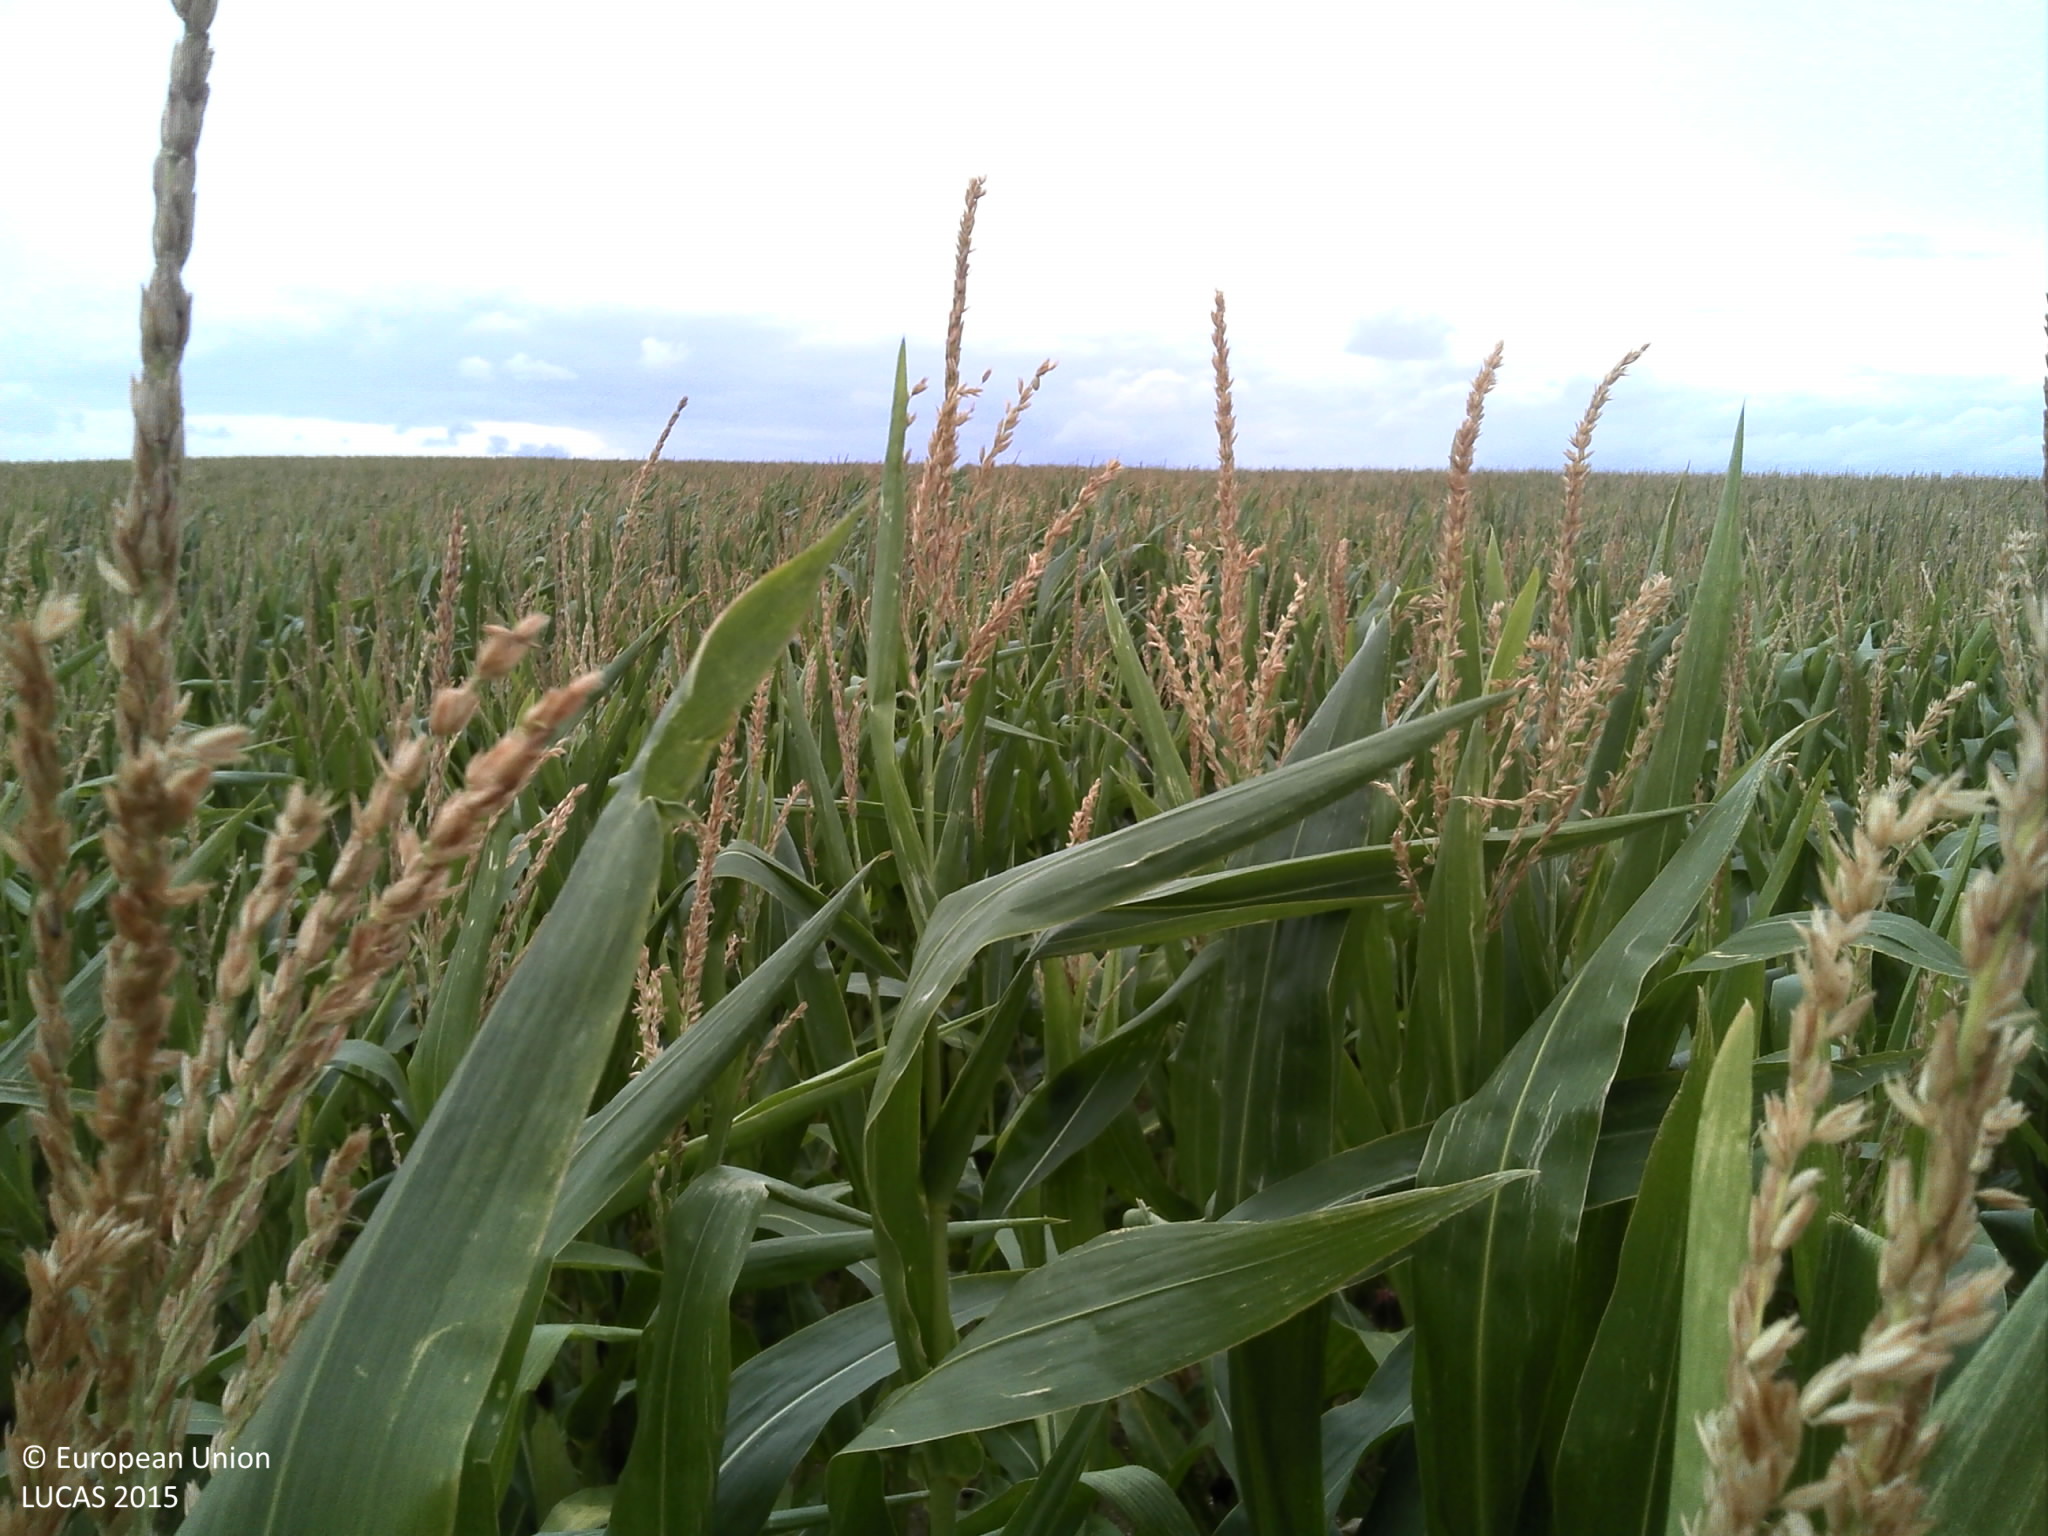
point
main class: Cropland
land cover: Maize
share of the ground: > 75 %
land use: Agriculture (excluding fallow land and kitchen gardens)
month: July
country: FR
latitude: 49.5085
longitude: 4.0980
